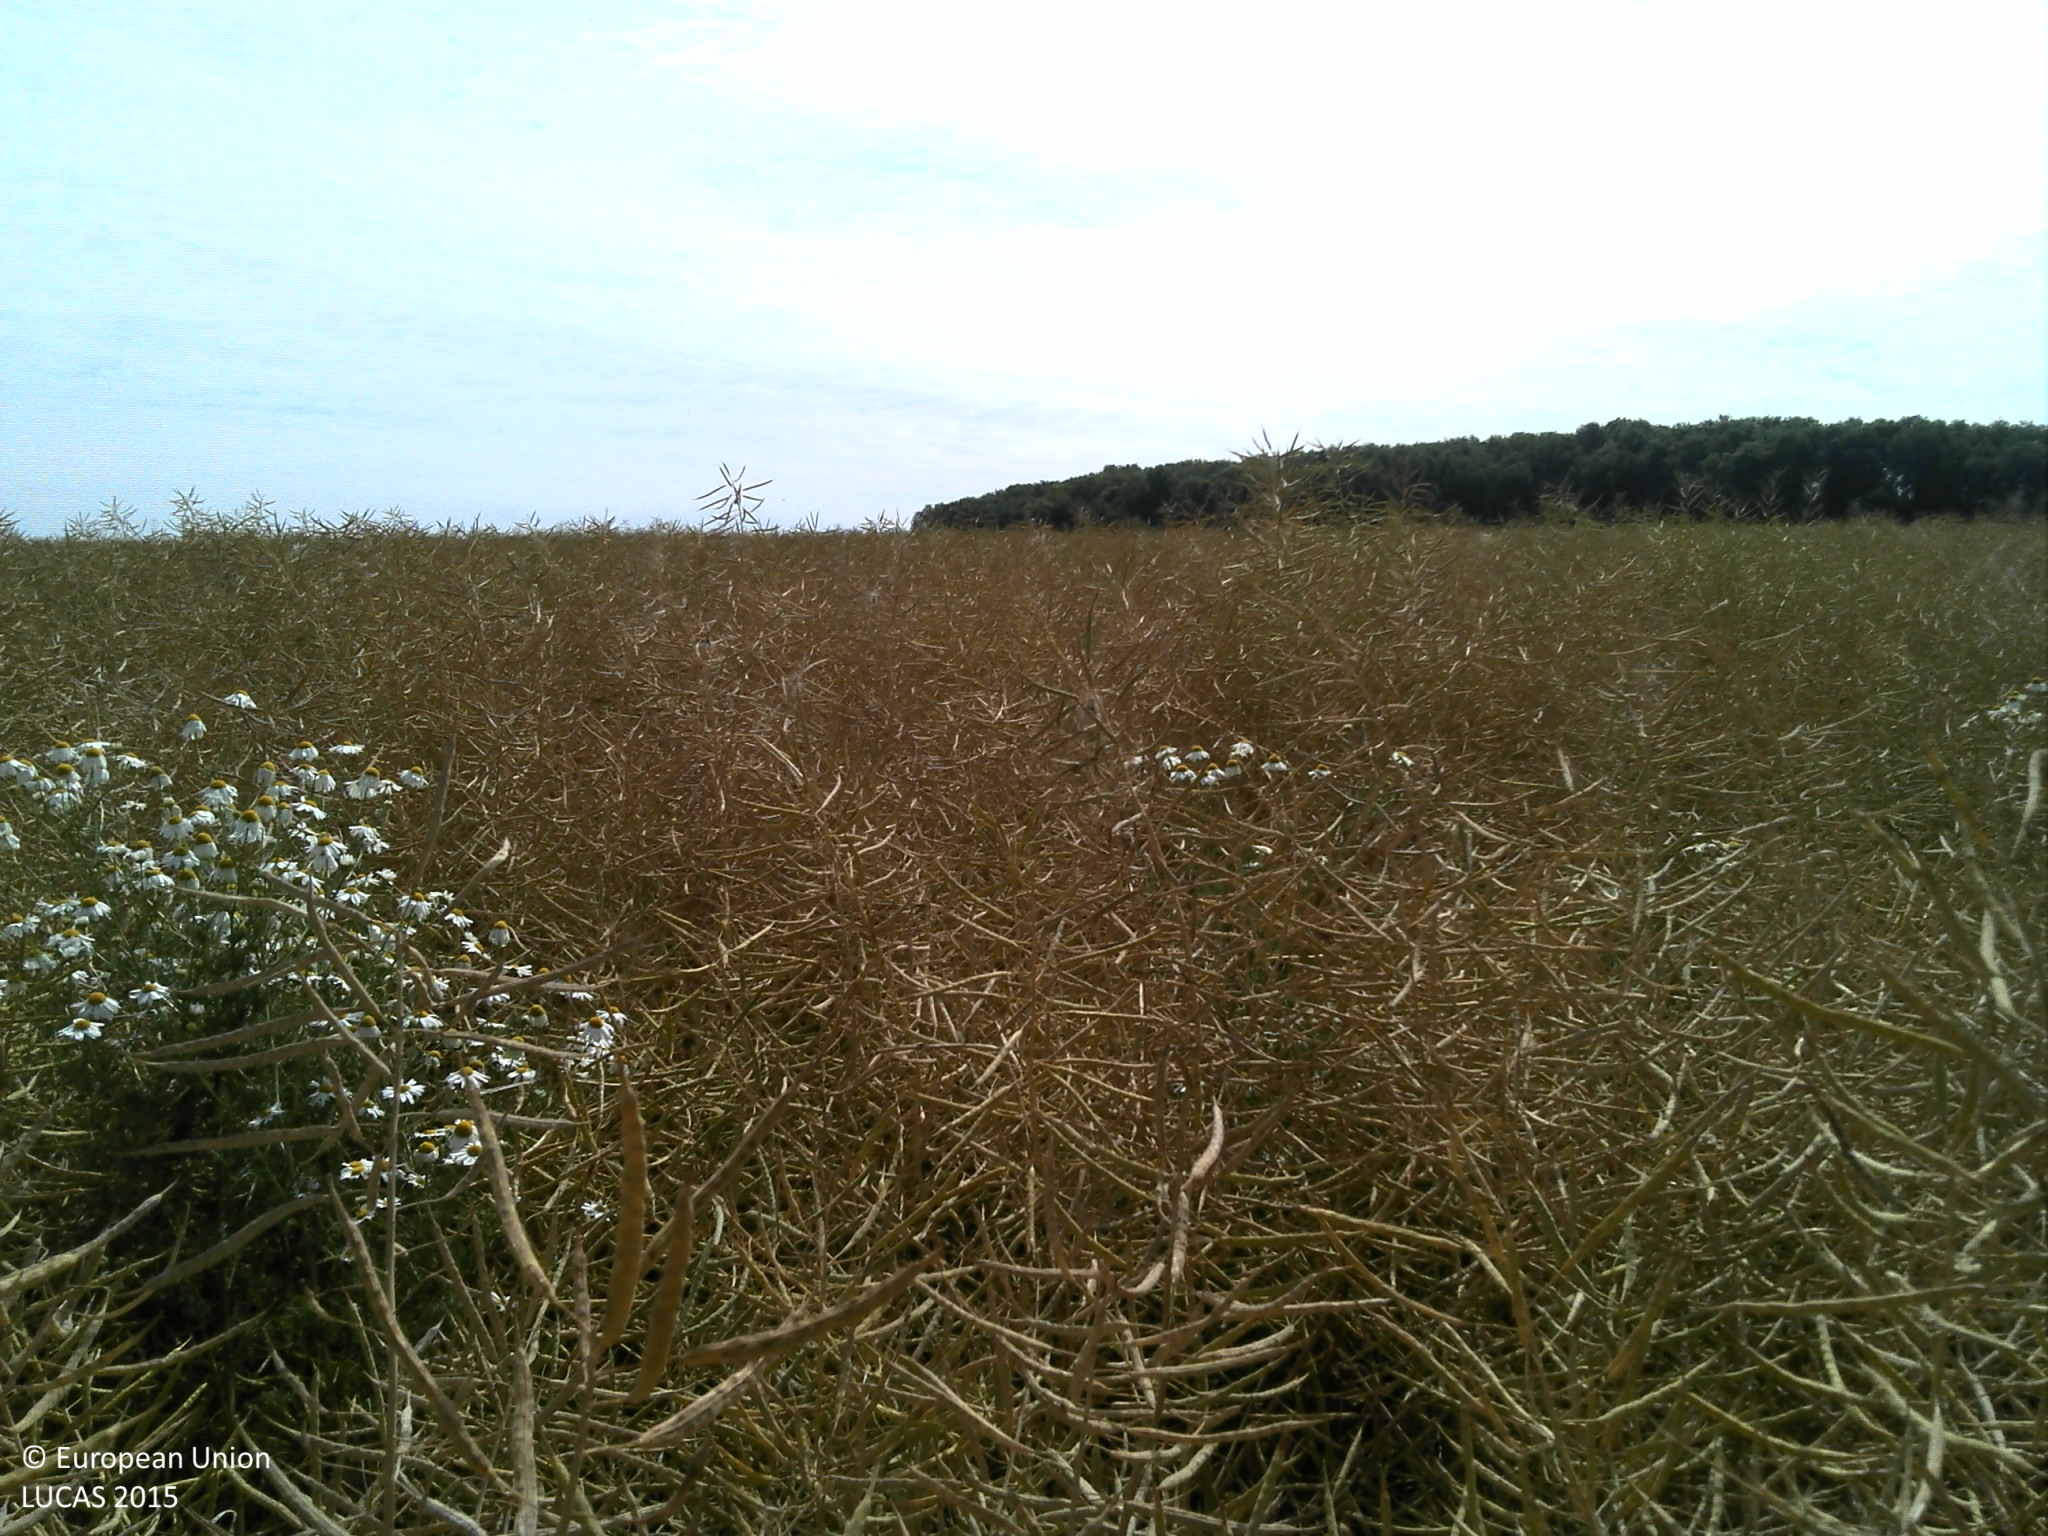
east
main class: Cropland
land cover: Rape and turnip rape
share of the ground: > 75 %
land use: Agriculture (excluding fallow land and kitchen gardens)
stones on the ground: > 50 %
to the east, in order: Rape and turnip rape
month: June
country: FR
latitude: 49.2149
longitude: 6.0320
